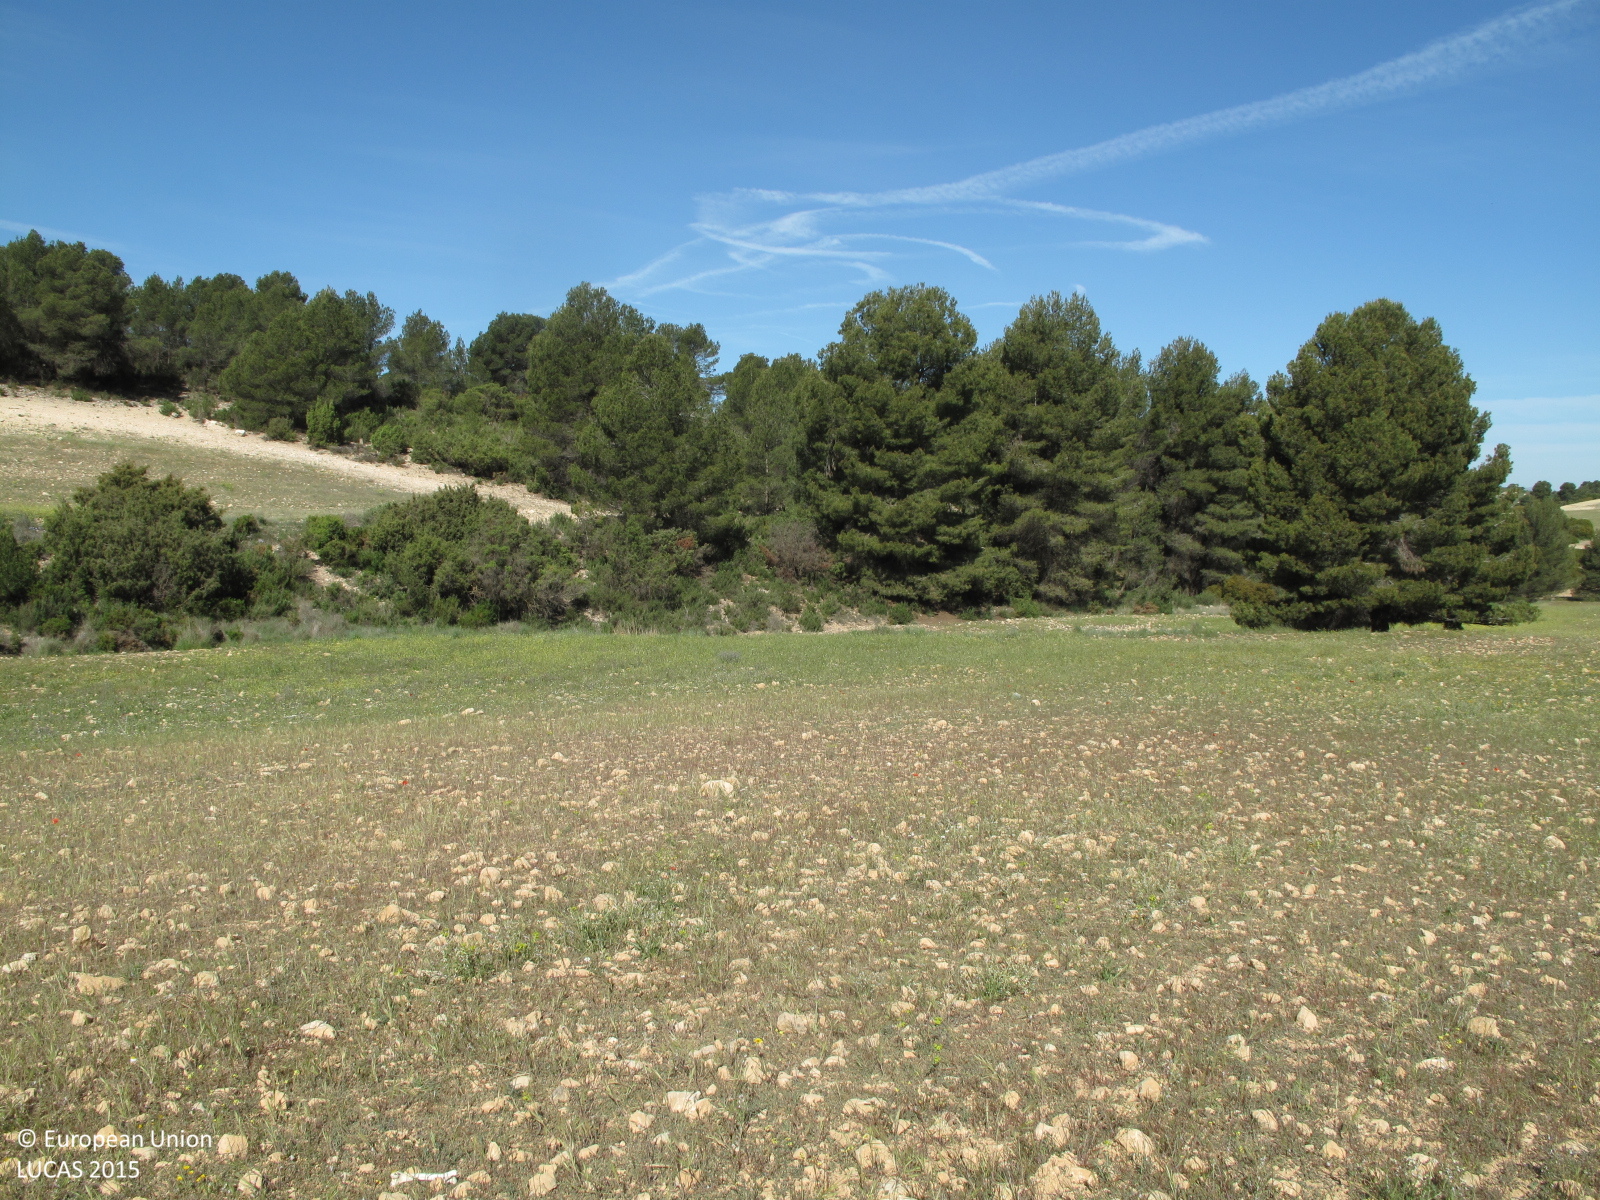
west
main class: Grassland
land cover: Spontaneously vegetated surfaces
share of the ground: 50 - 75 %
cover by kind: herbaceous plants 70 %, unconsolidated bare surface 30 %
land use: Fallow land
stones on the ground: 25 - 50 %
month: May
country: ES
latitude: 38.8978
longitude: -1.0053
